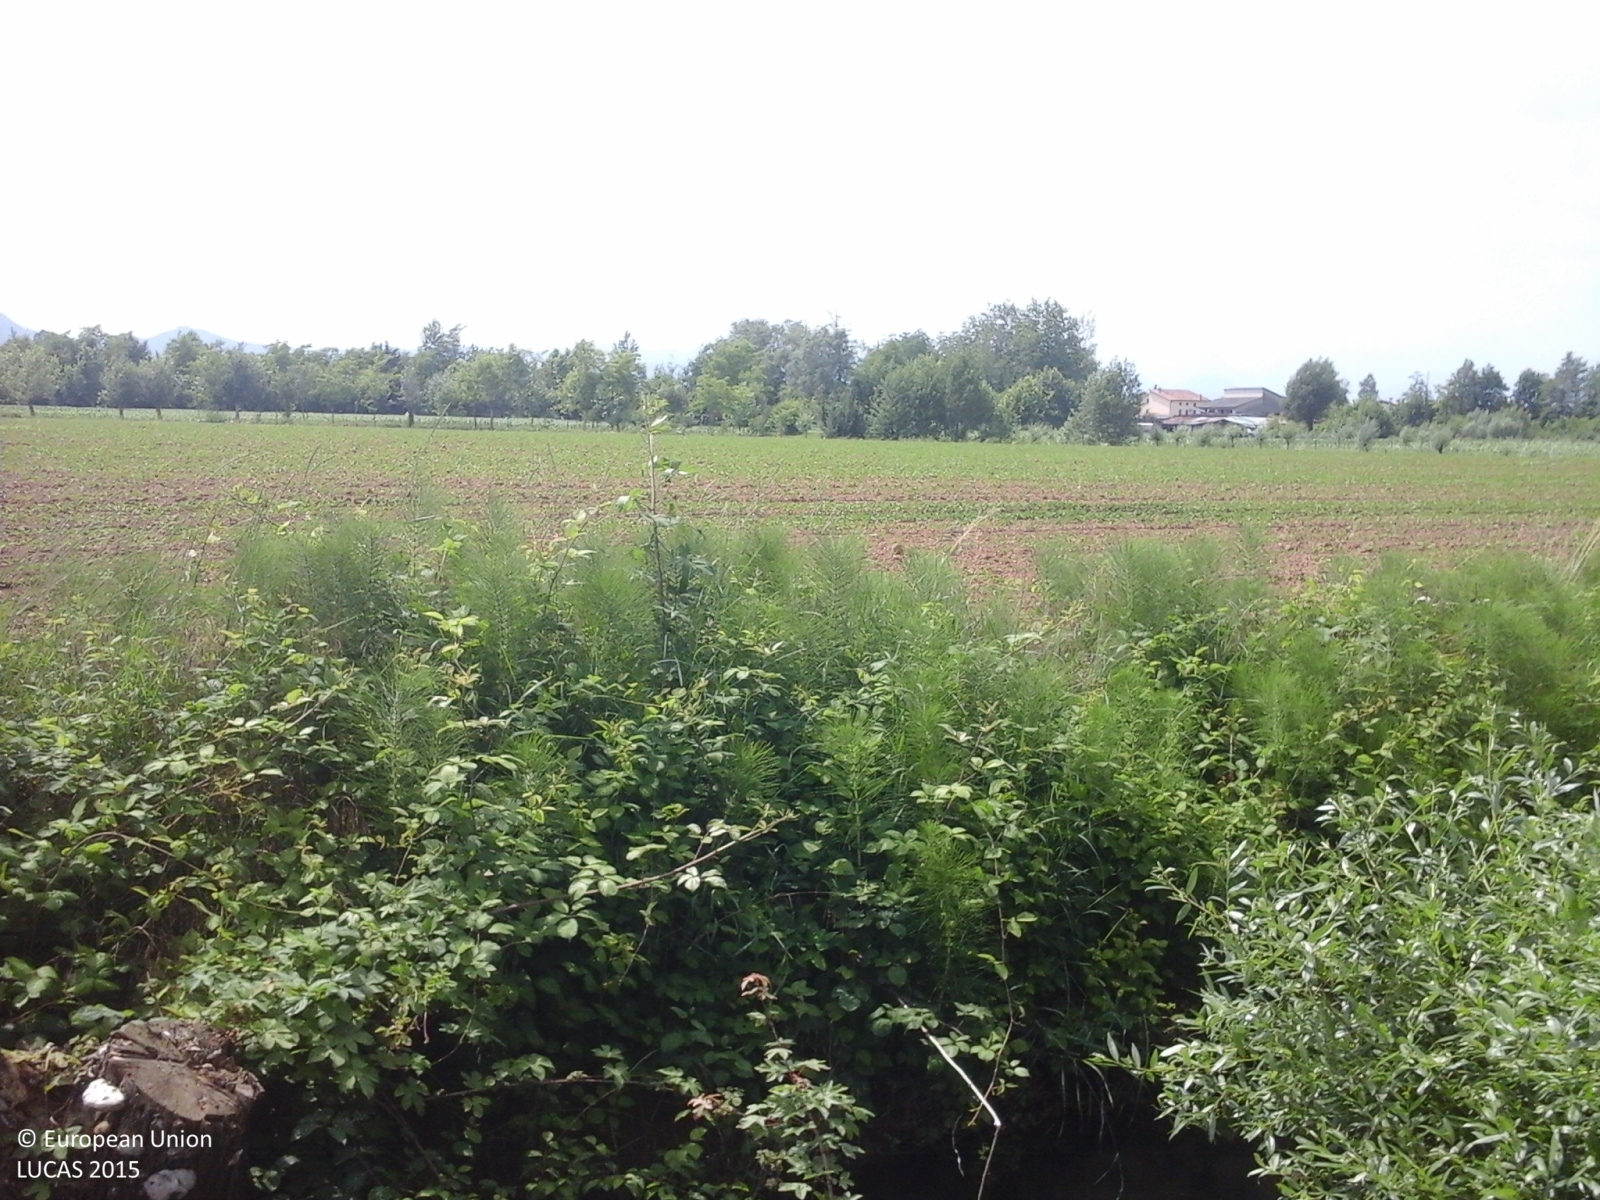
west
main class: Cropland
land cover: Soya
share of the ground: < 10 %
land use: Agriculture (excluding fallow land and kitchen gardens)
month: May
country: IT
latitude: 45.6196
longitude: 11.5237
